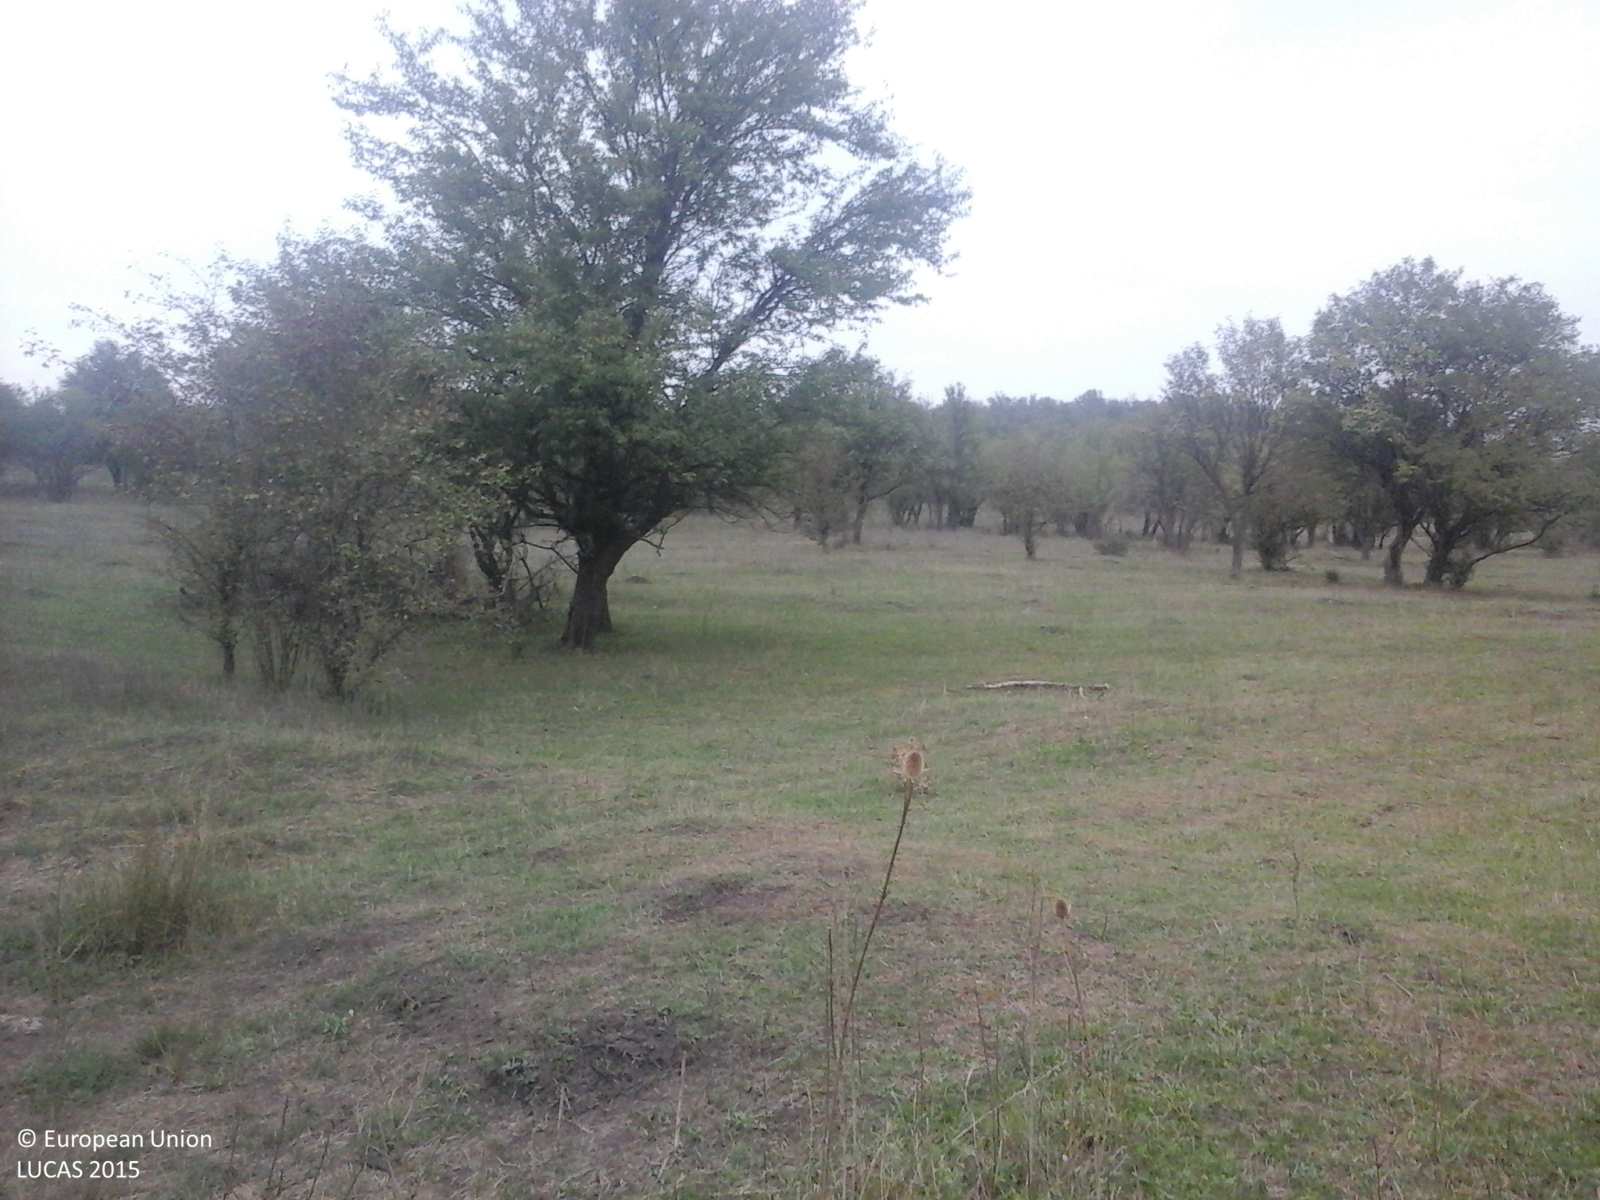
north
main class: Grassland
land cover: Grassland with sparse tree/shrub cover
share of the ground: > 75 %
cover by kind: herbaceous plants 85 %, shrubs 10 %, broadleaved forest trees 5 %
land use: Agriculture (excluding fallow land and kitchen gardens)
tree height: < 5 m
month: September
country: RO
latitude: 45.7961
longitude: 22.9580
